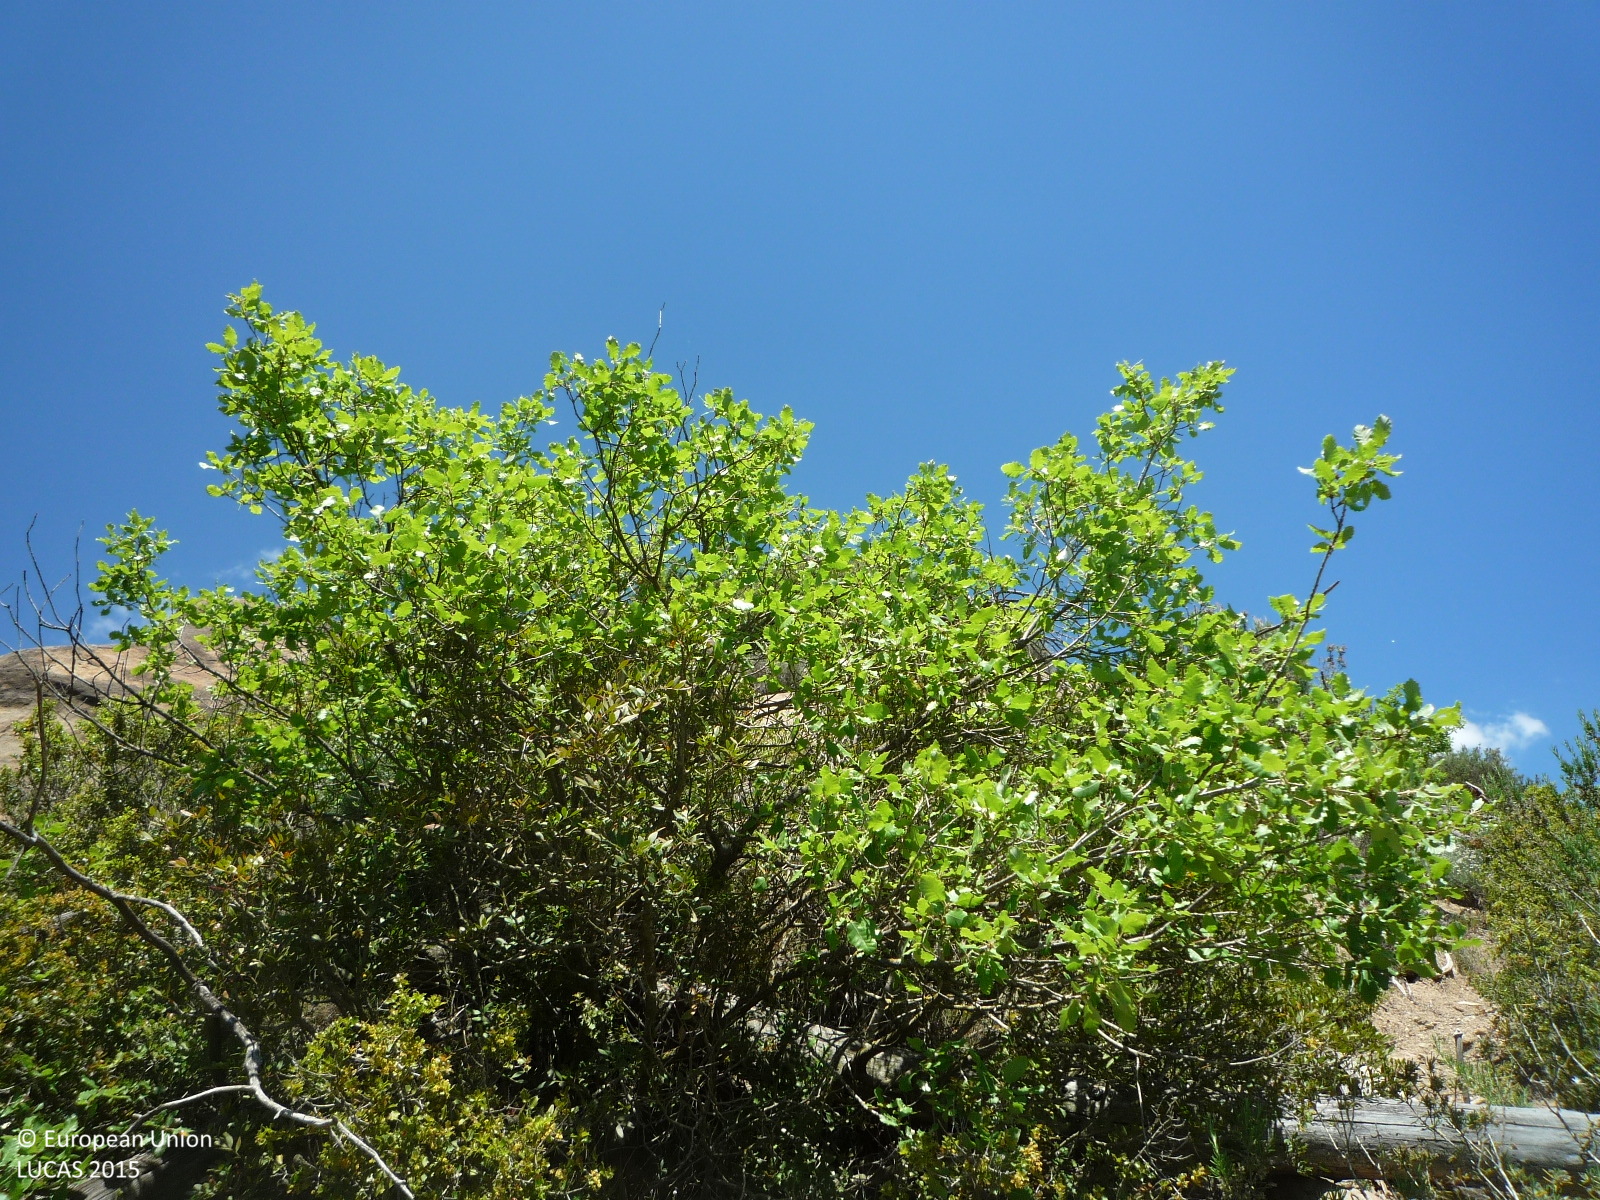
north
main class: Shrubland
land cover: Shrubland with sparse tree cover
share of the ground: > 75 %
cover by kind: shrubs 95 %, coniferous forest trees 5 %
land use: Semi-natural and natural areas not in use
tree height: < 5 m
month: May
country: ES
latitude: 41.8165
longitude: 1.6234
